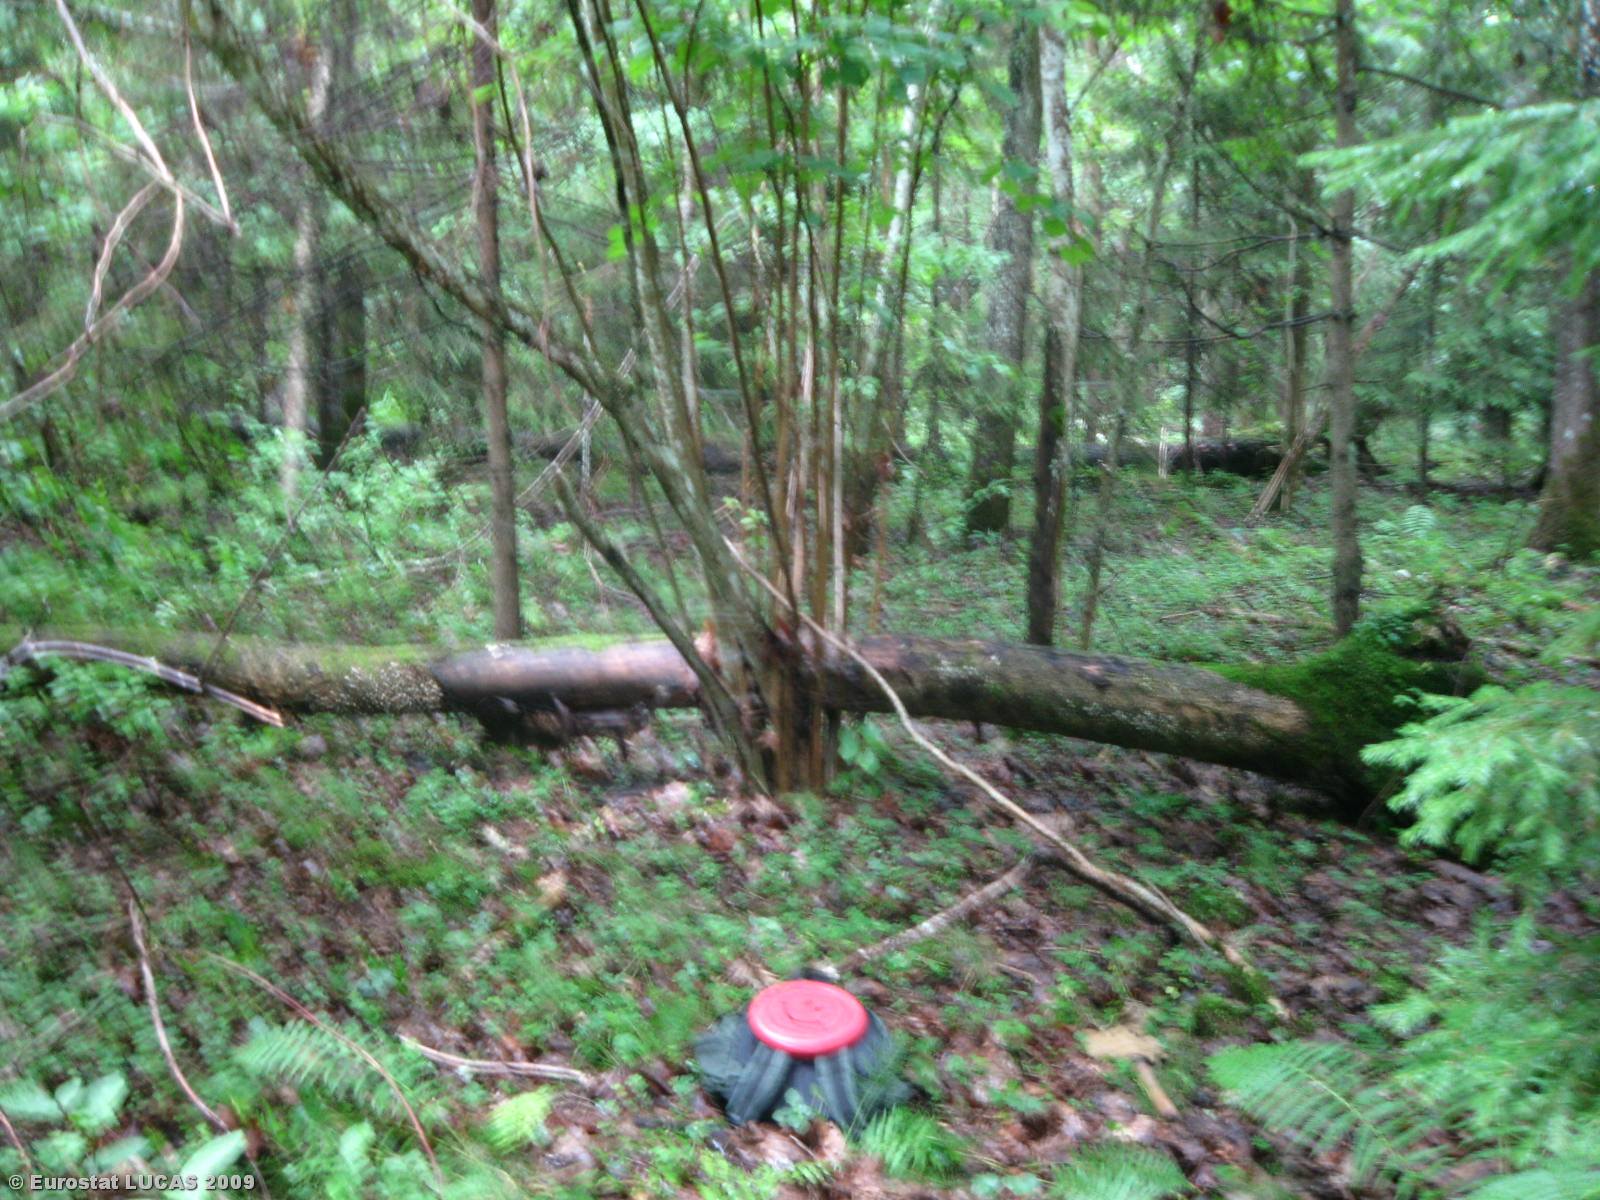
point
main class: Woodland
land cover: Mixed woodland
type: hemiboreal forest and nemoral coniferous forest and mixed broadleaved-coniferous forest
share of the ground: > 75 %
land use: Forestry
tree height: > 5 m
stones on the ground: < 10 %
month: July
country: LT
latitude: 55.1525
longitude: 24.8446
